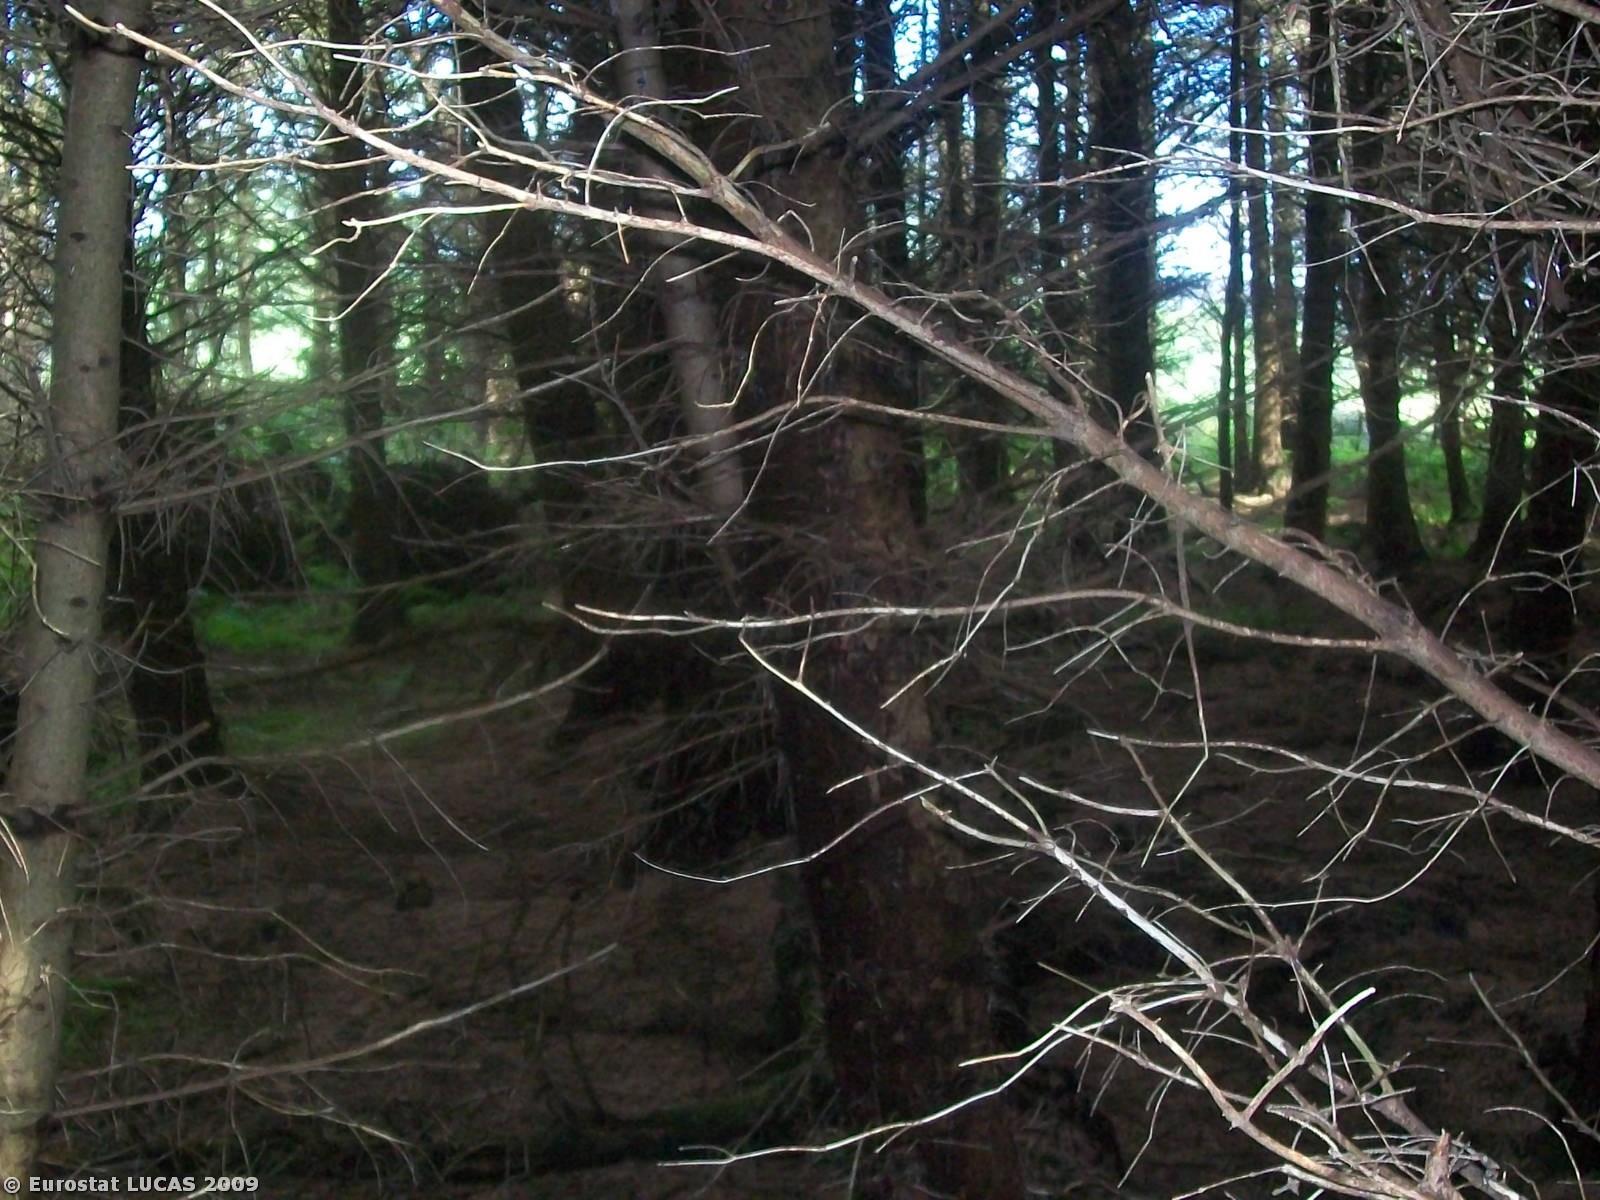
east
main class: Woodland
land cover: Coniferous woodland
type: plantations and self-sown exotic forest
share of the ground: > 75 %
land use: Forestry
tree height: > 5 m
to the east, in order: Coniferous woodland; Grassland without tree/shrub cover; Broadleaved woodland; Grassland without tree/shrub cover; Managed hedges; Grassland without tree/shrub cover
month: July
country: IE
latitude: 54.3753
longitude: -8.5274
